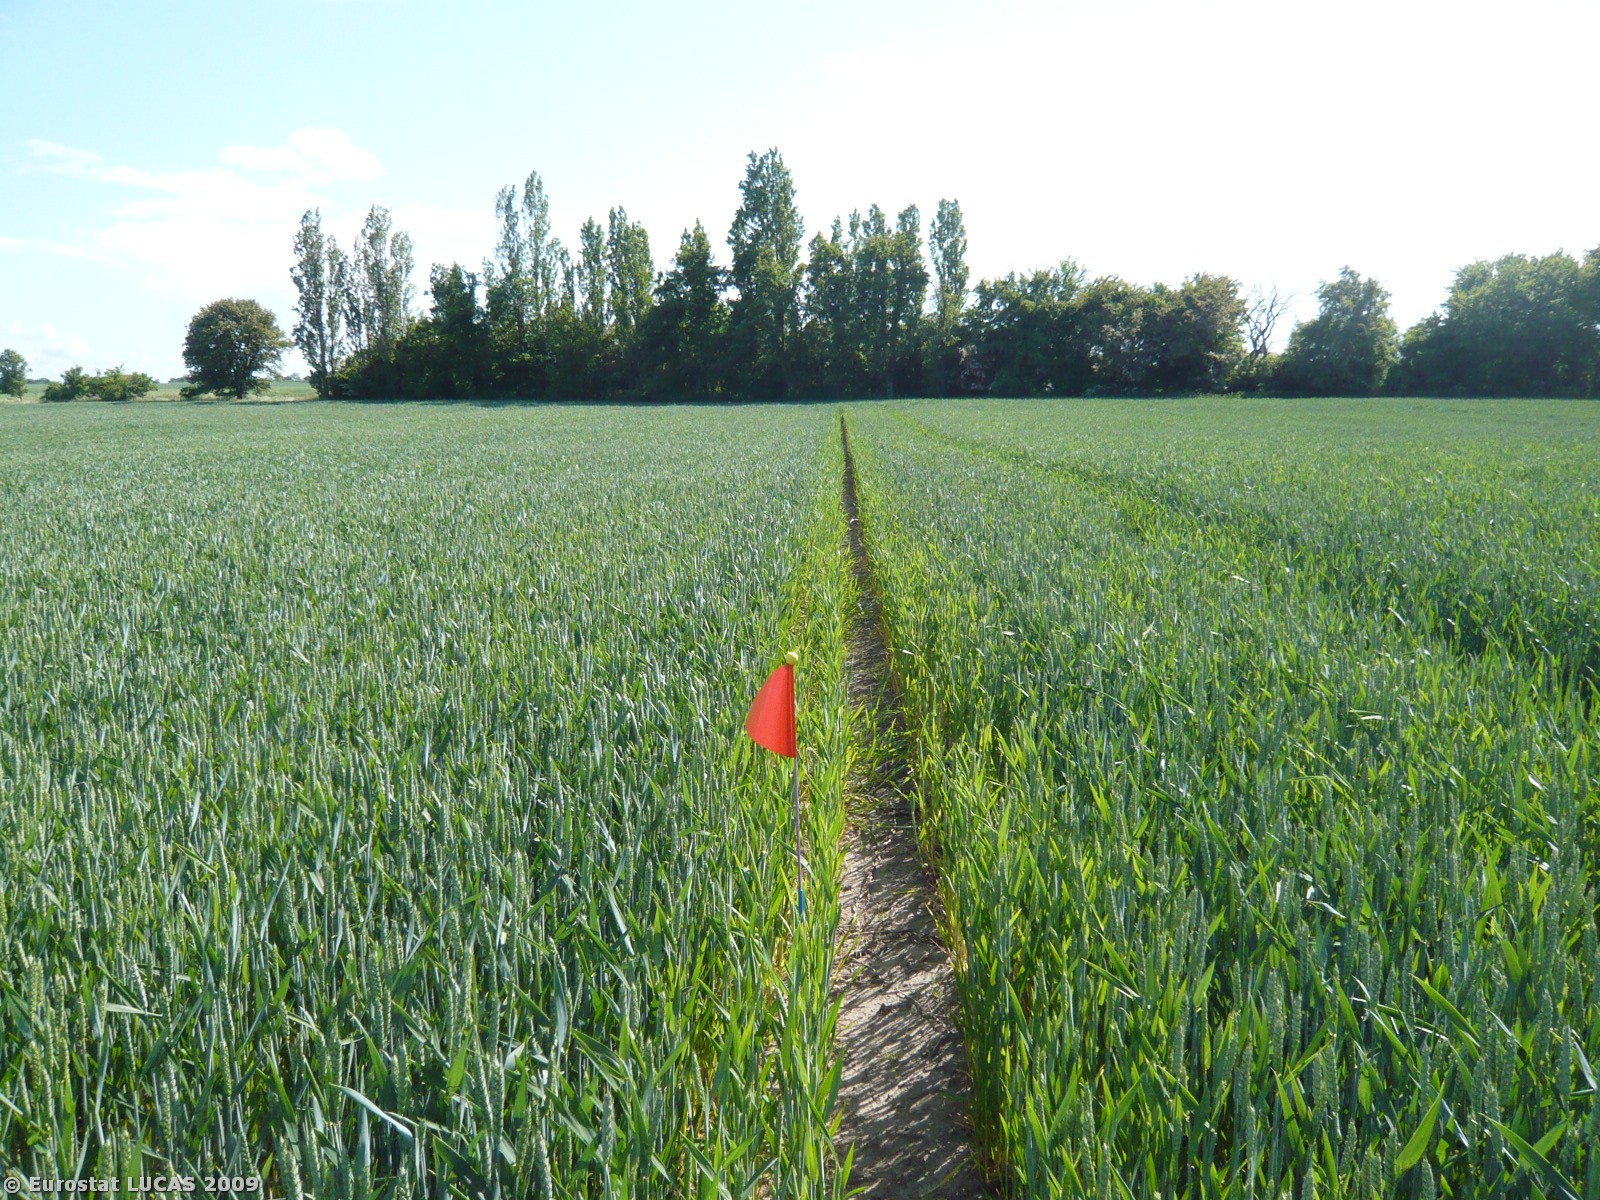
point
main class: Cropland
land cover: Common wheat
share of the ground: > 75 %
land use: Agriculture (excluding fallow land and kitchen gardens)
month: June
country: DK
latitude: 55.3006
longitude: 11.2748
